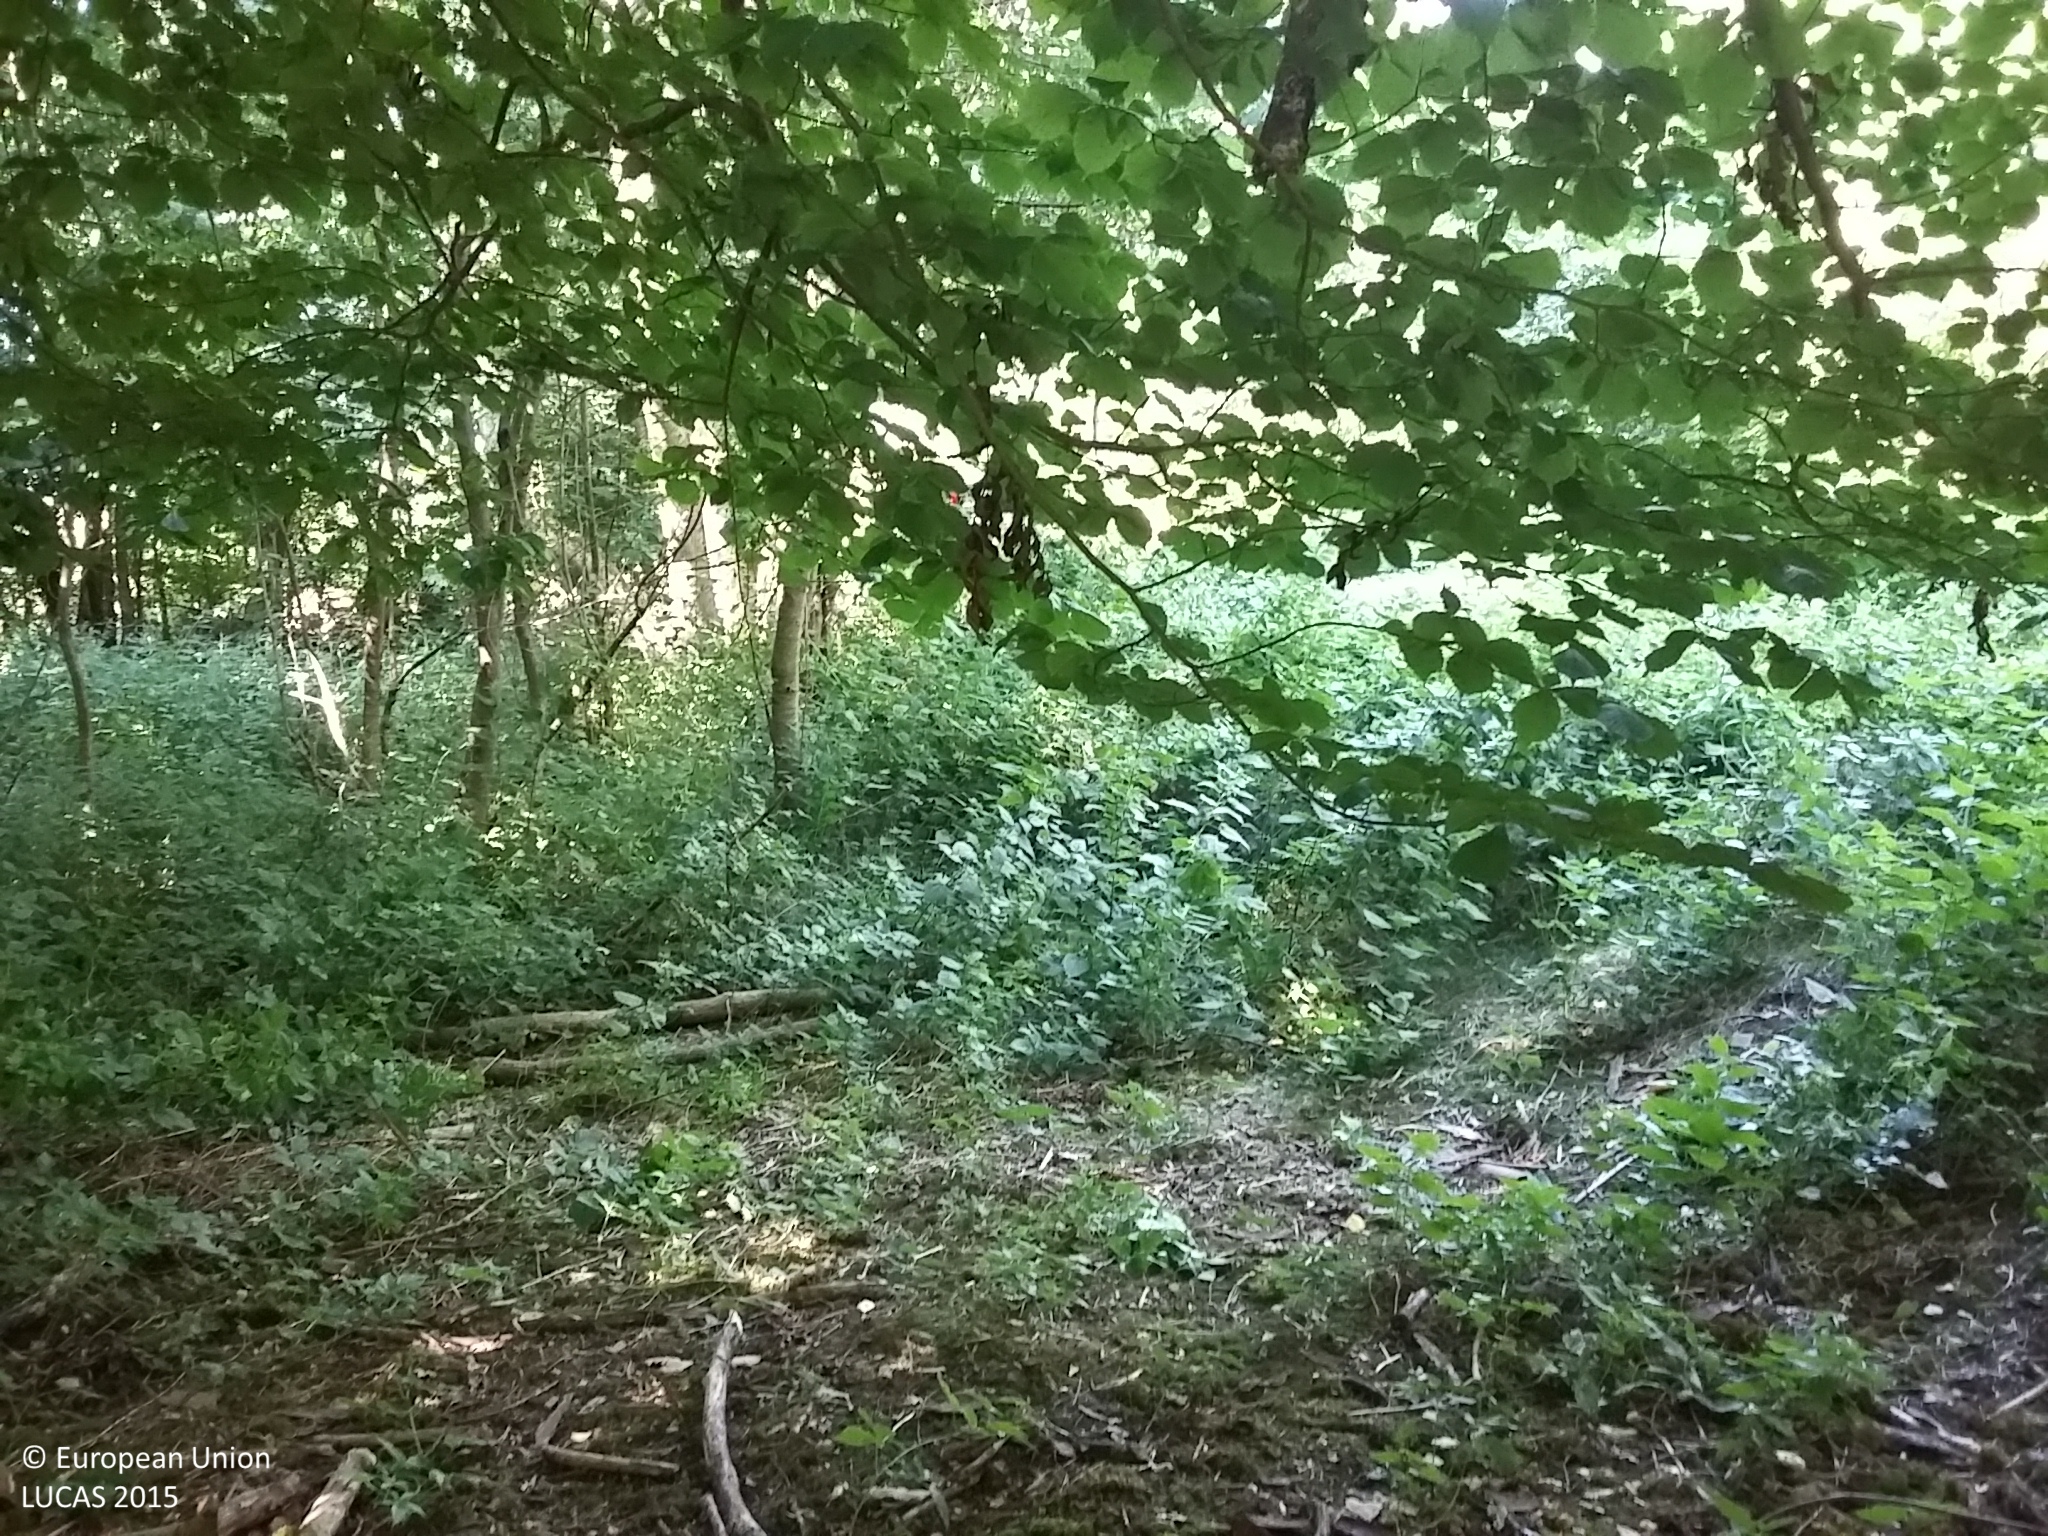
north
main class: Woodland
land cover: Broadleaved woodland
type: beech forest
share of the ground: > 75 %
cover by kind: broadleaved forest trees 80 %, herbaceous plants 20 %
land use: Forestry
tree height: > 5 m
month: August
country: DK
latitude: 55.0915
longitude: 14.7476
